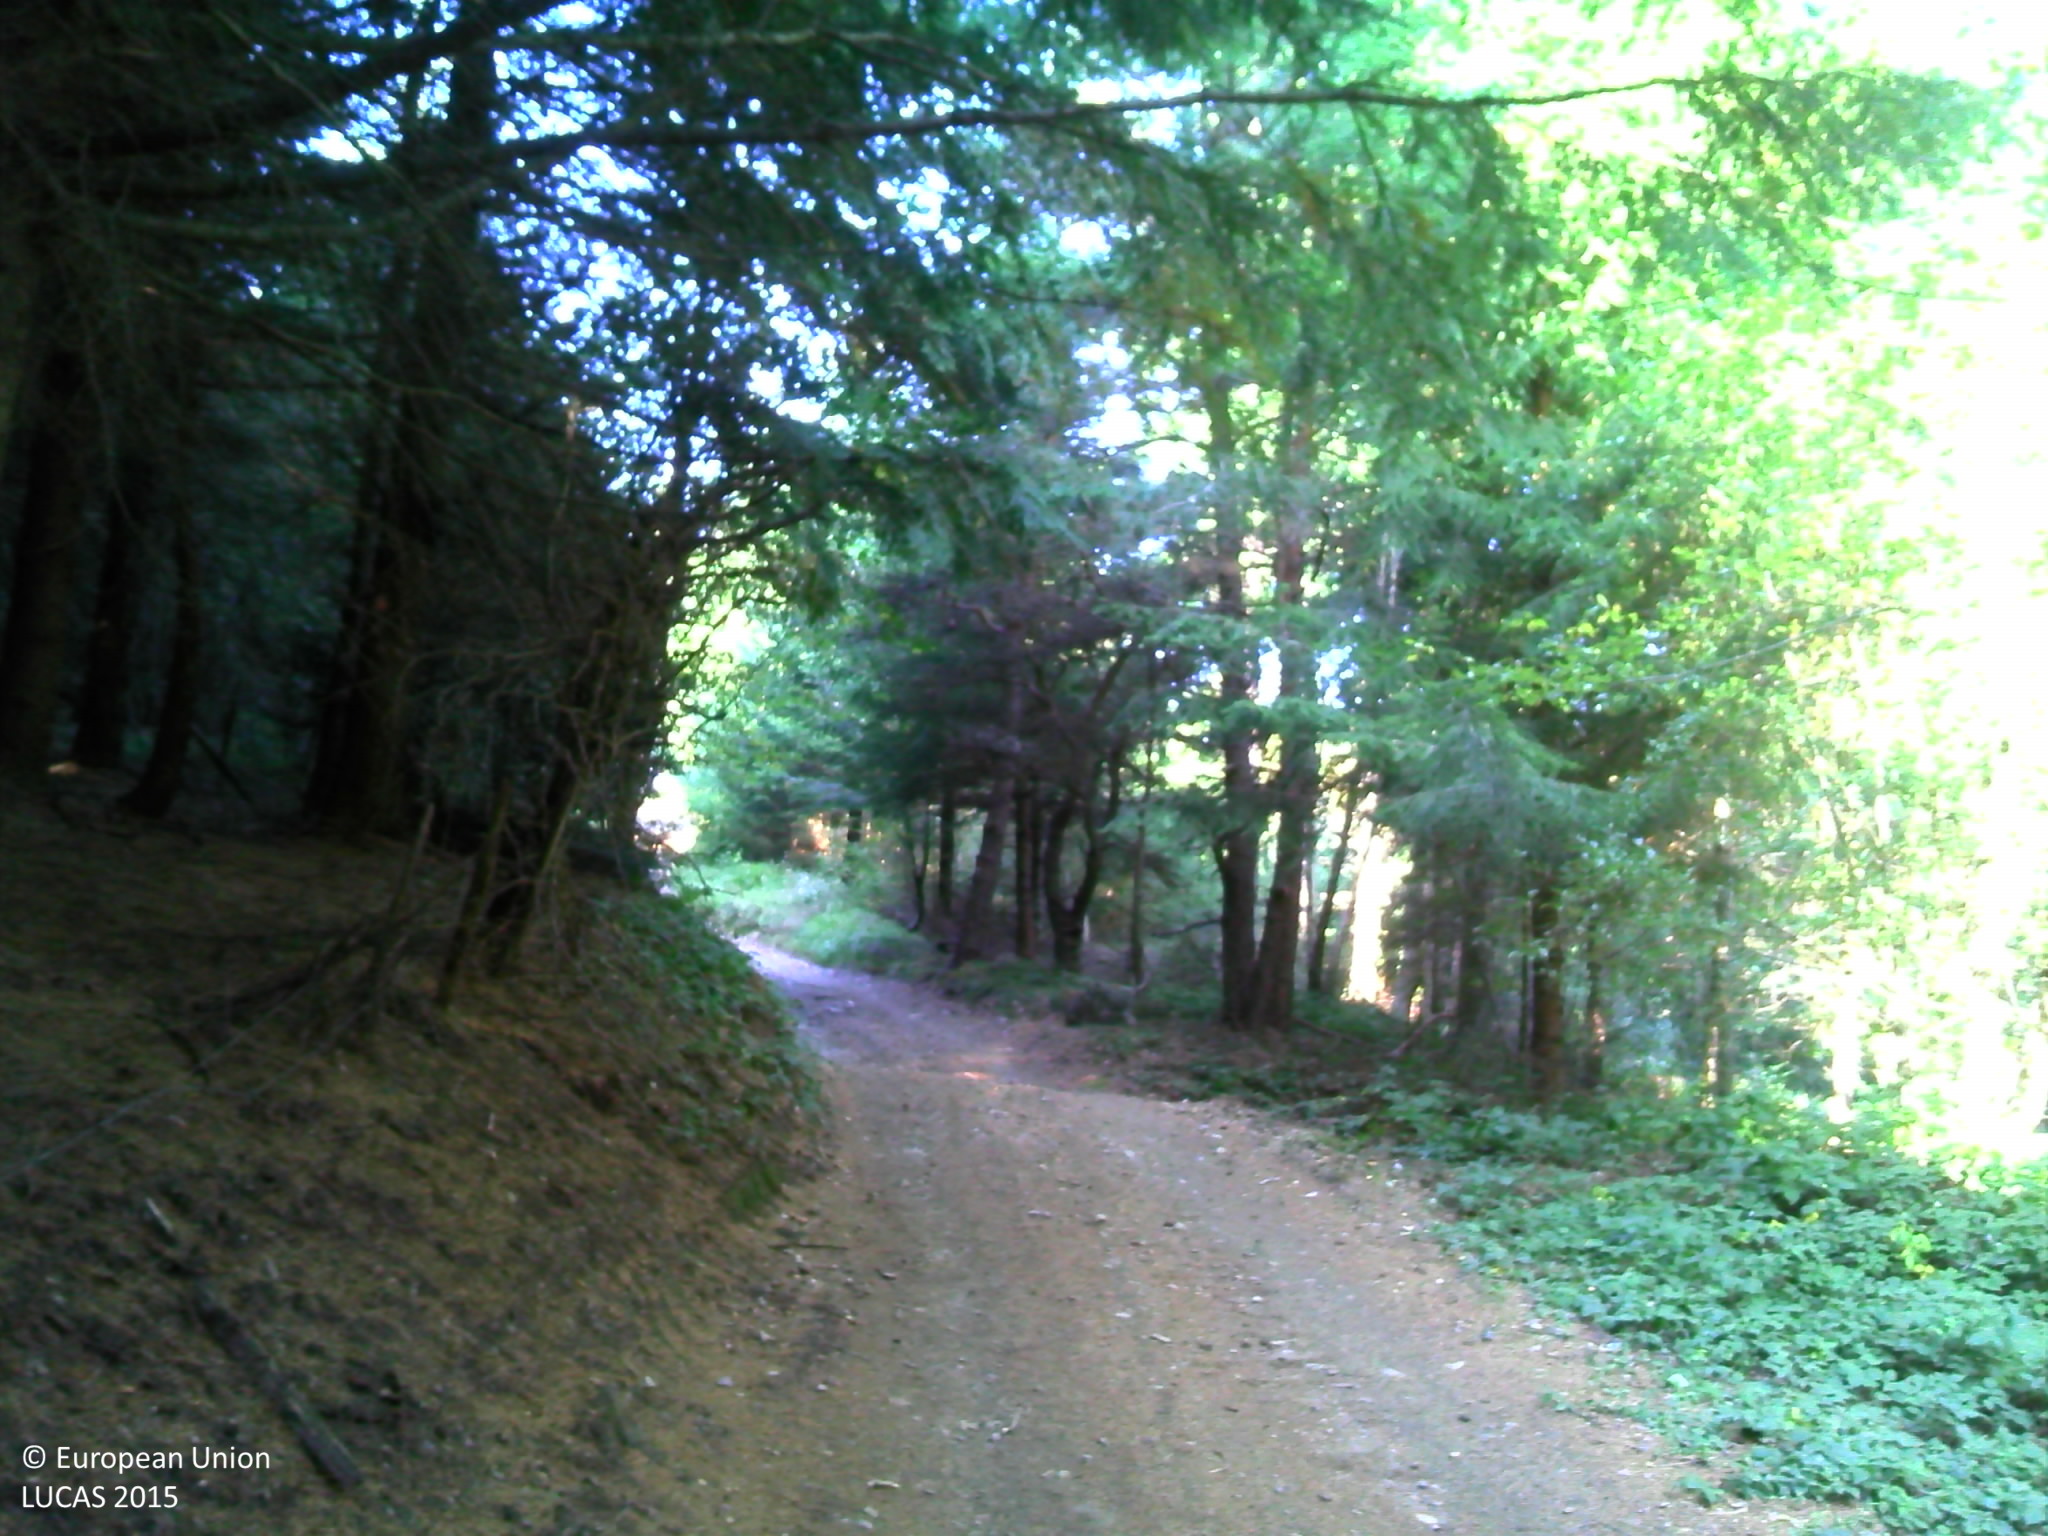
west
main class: Woodland
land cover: Spruce dominated coniferous woodland
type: alpine coniferous forest
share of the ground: > 75 %
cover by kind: coniferous forest trees 95 %, herbaceous plants 5 %
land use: Forestry
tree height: > 5 m
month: September
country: FR
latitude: 45.4190
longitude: 4.5729
